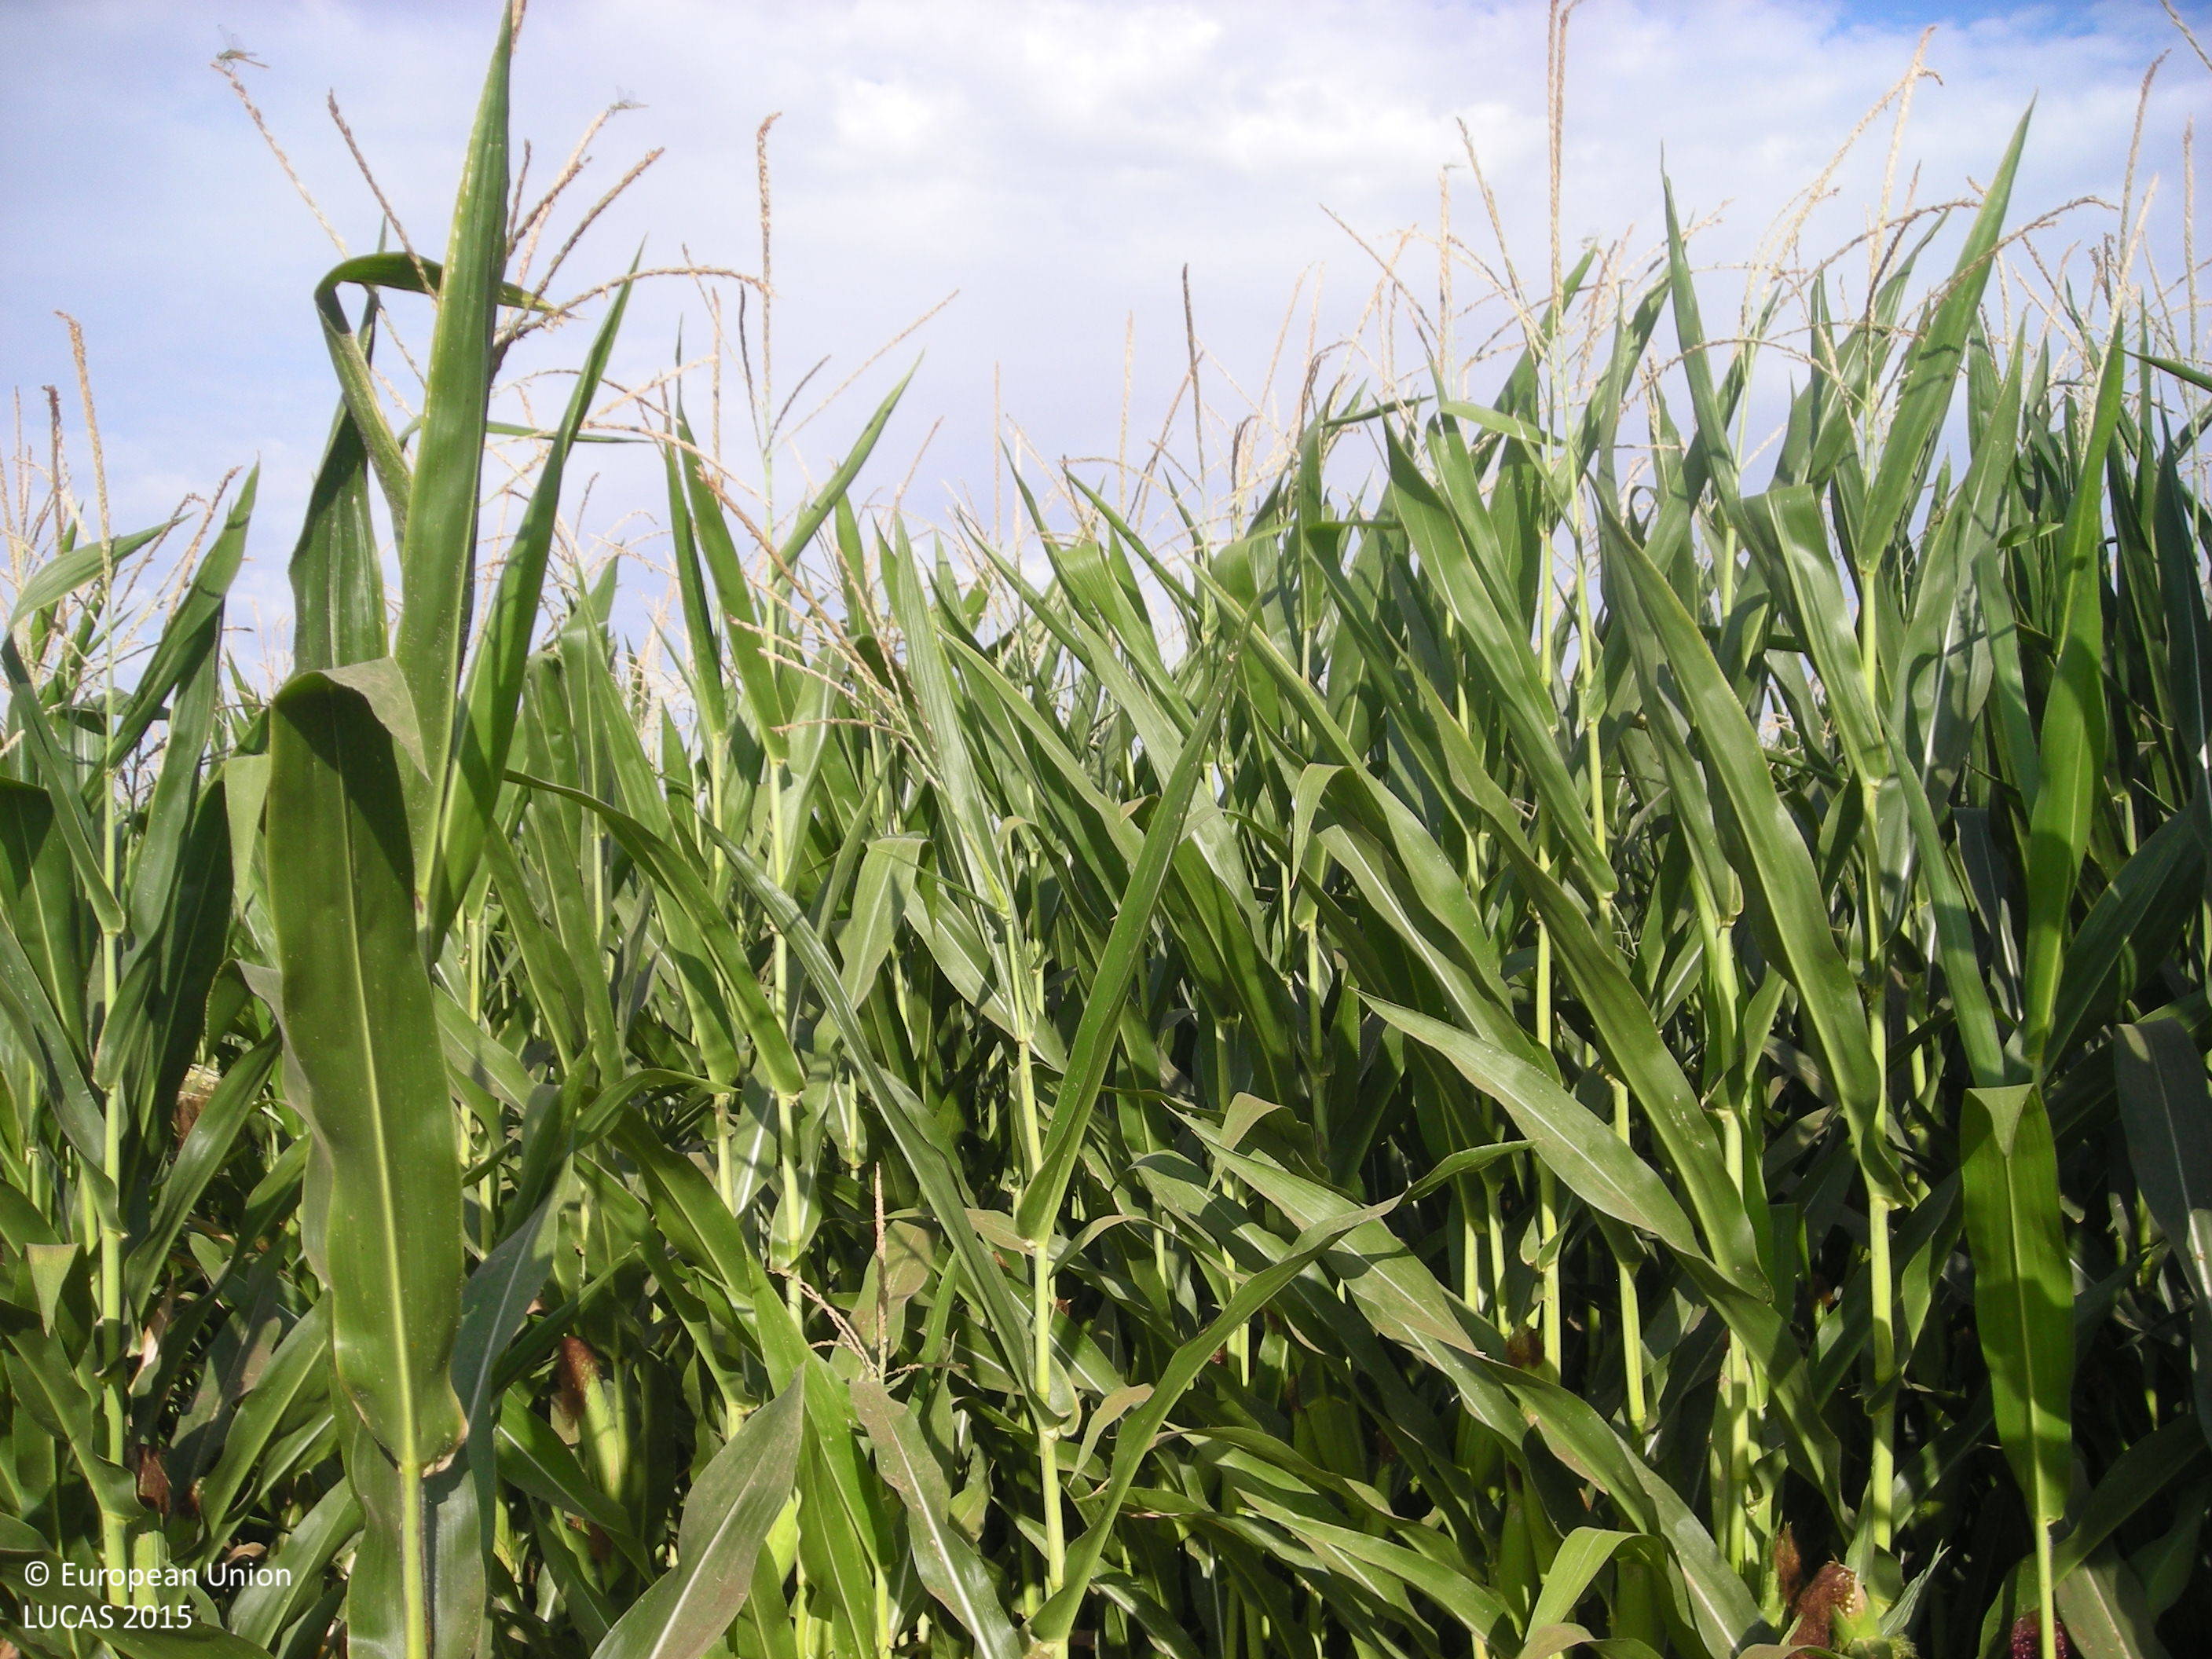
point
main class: Cropland
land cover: Maize
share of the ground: > 75 %
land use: Agriculture (excluding fallow land and kitchen gardens)
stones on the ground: < 10 %
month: July
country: ES
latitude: 39.1213
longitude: -5.9342
